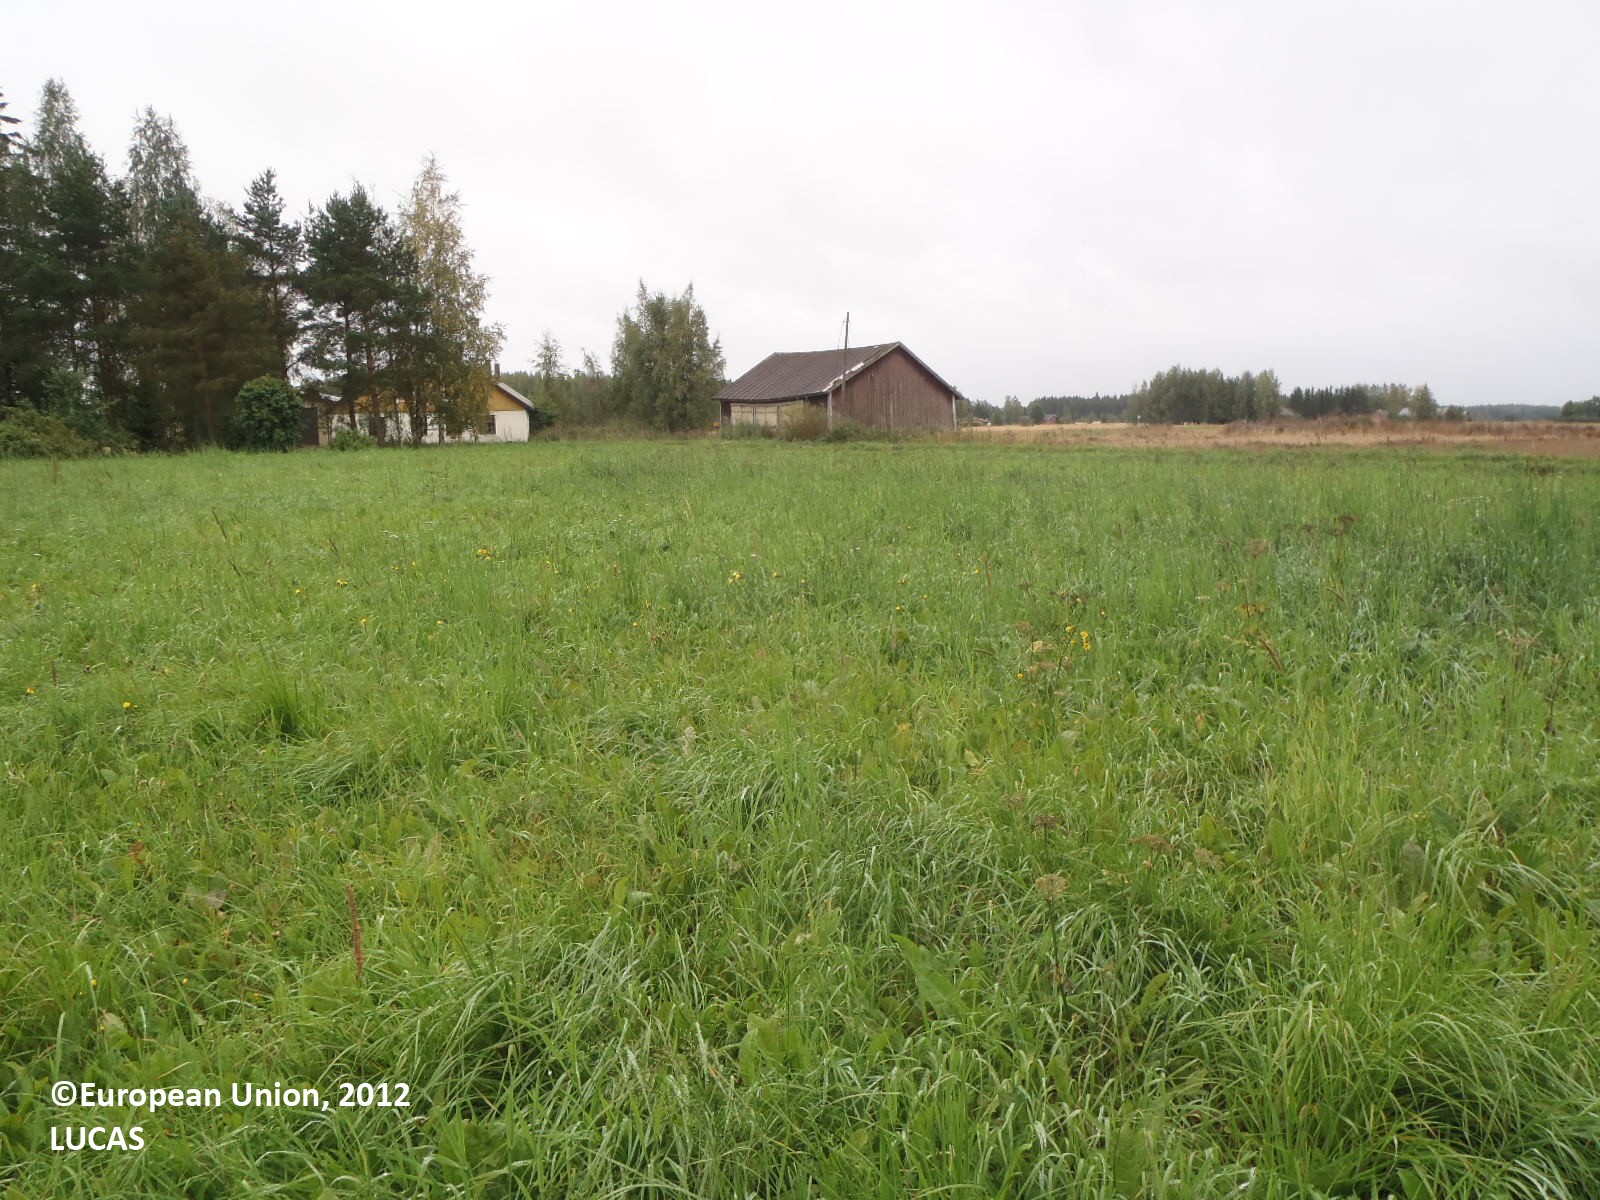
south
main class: Grassland
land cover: Grassland without tree/shrub cover
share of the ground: > 75 %
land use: Agriculture (excluding fallow land and kitchen gardens)
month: September
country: FI
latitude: 61.0315
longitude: 22.6741
